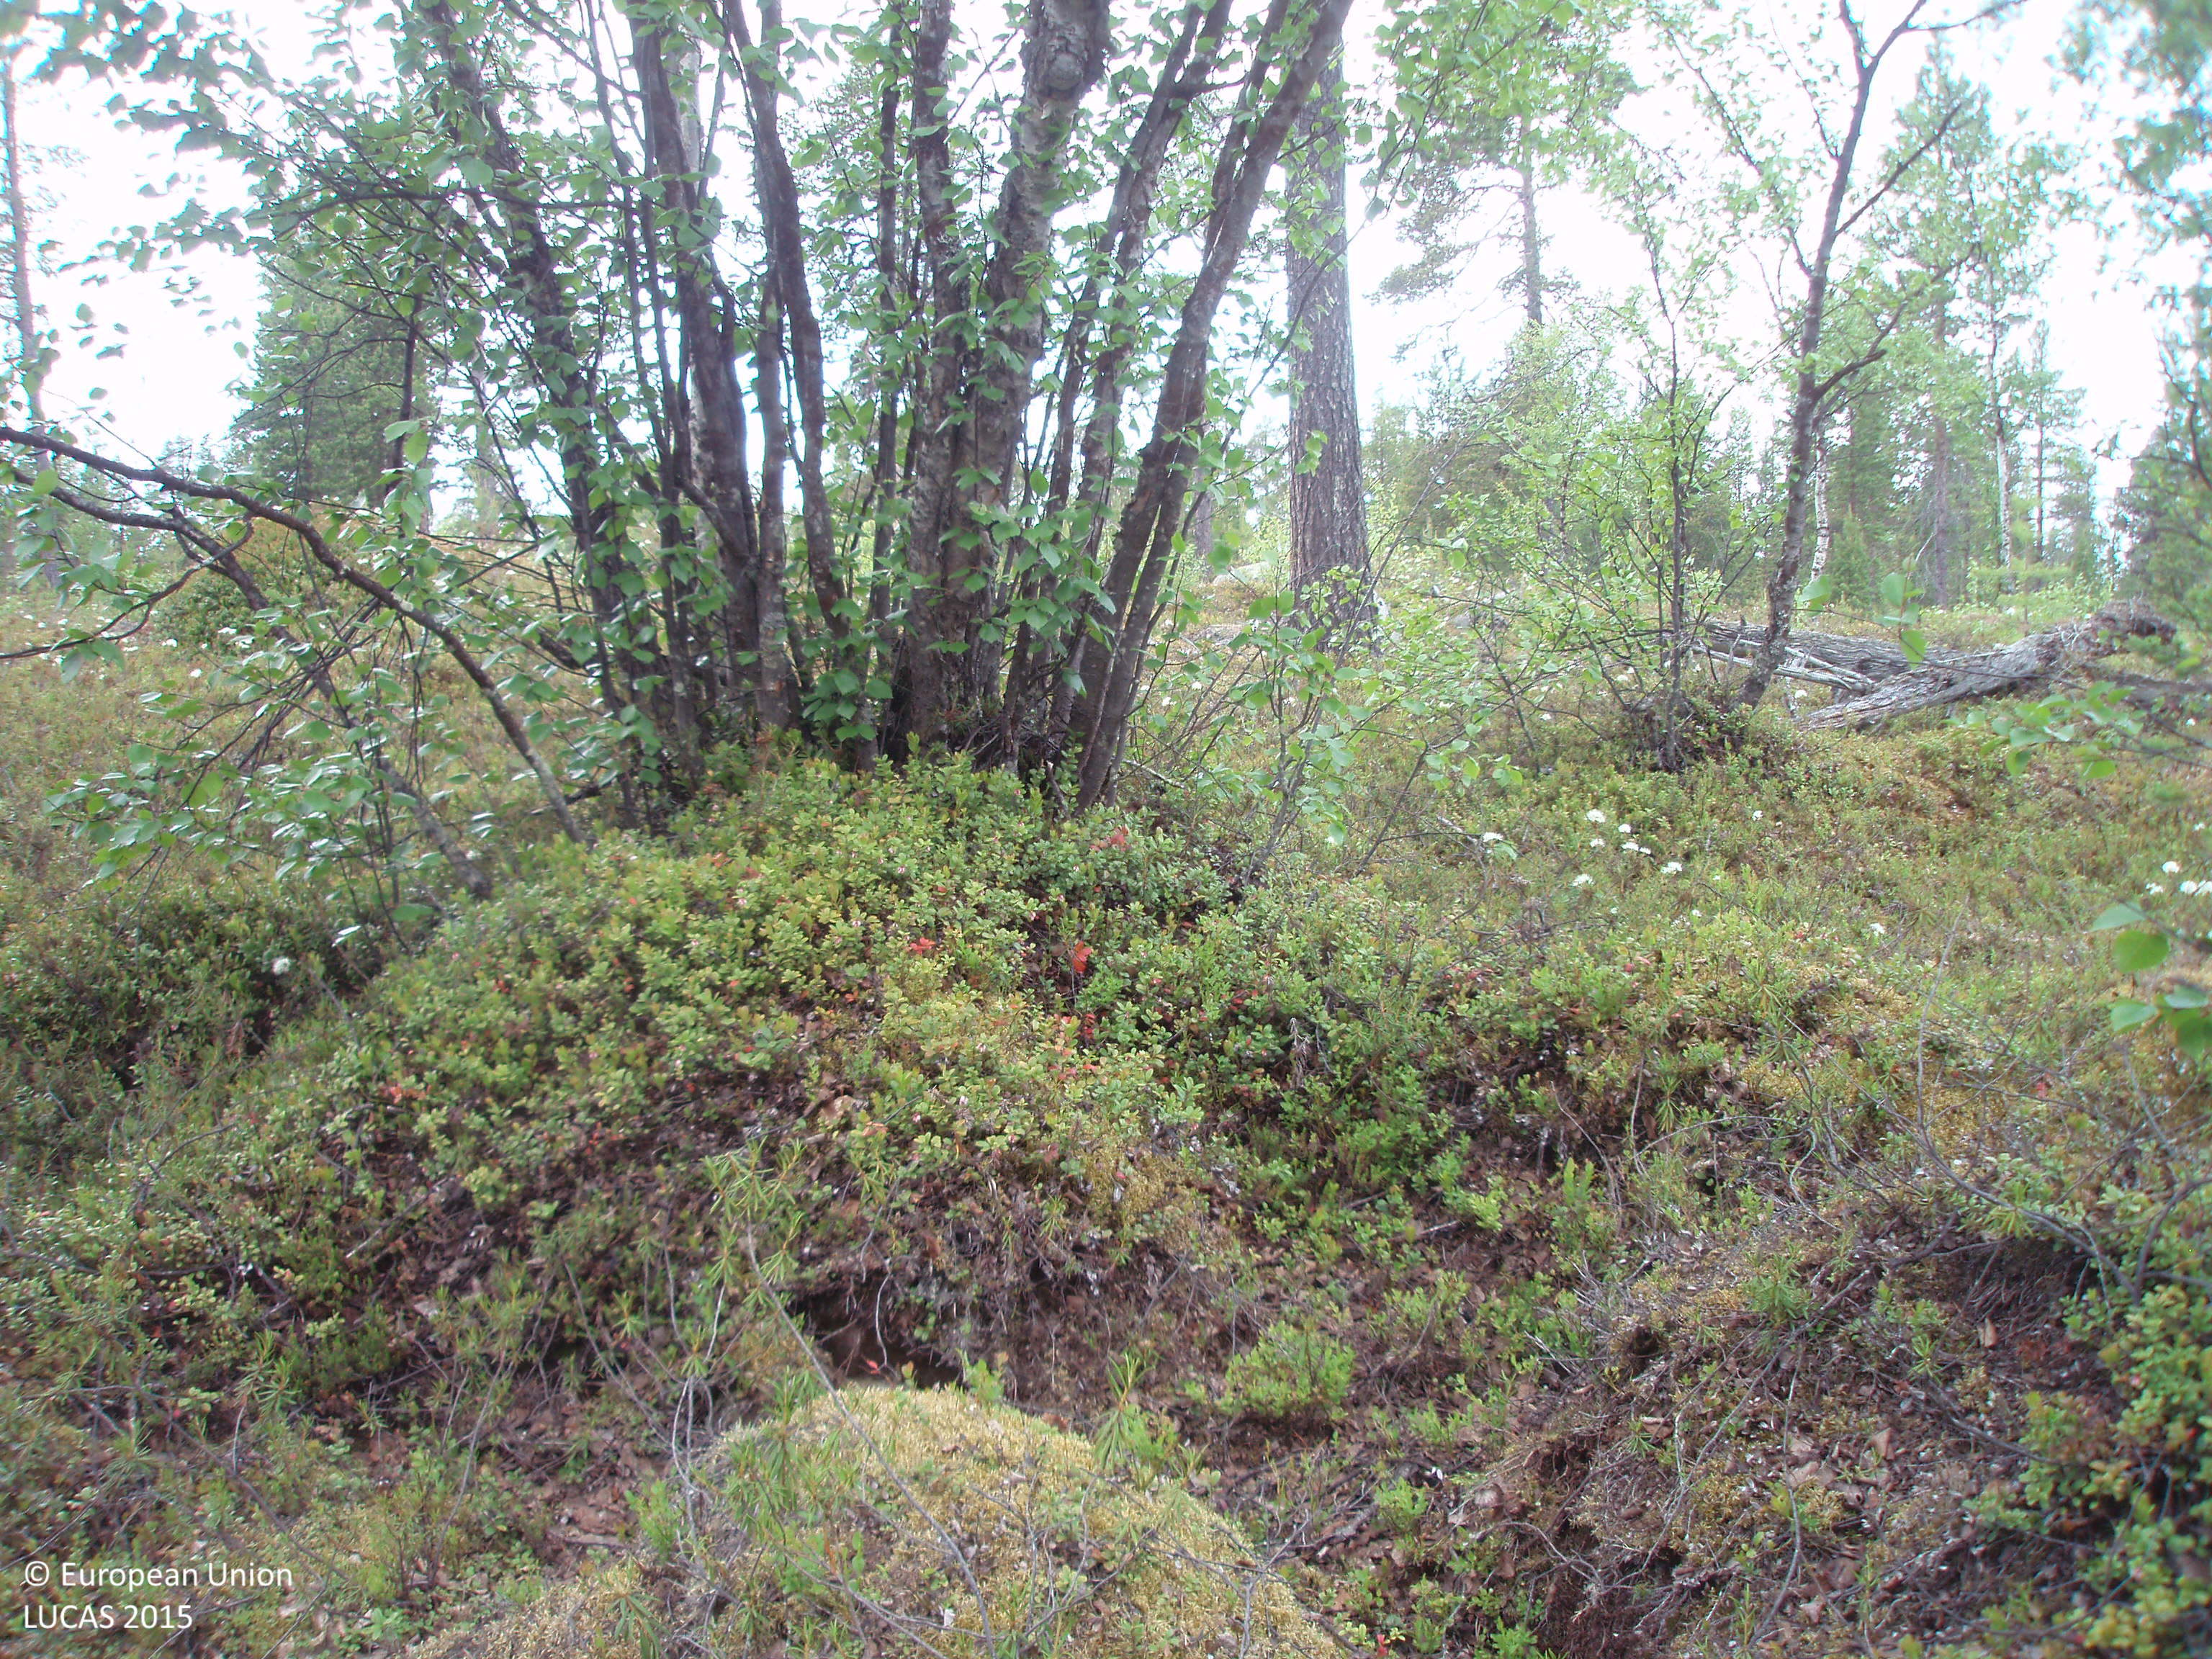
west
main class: Woodland
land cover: Pine dominated mixed woodland
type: boreal forest
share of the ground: > 75 %
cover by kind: broadleaved forest trees 50 %, coniferous forest trees 25 %, shrubs 25 %
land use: Forestry
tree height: > 5 m
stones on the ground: 10 - 25 %
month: July
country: FI
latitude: 69.1573
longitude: 27.7796
